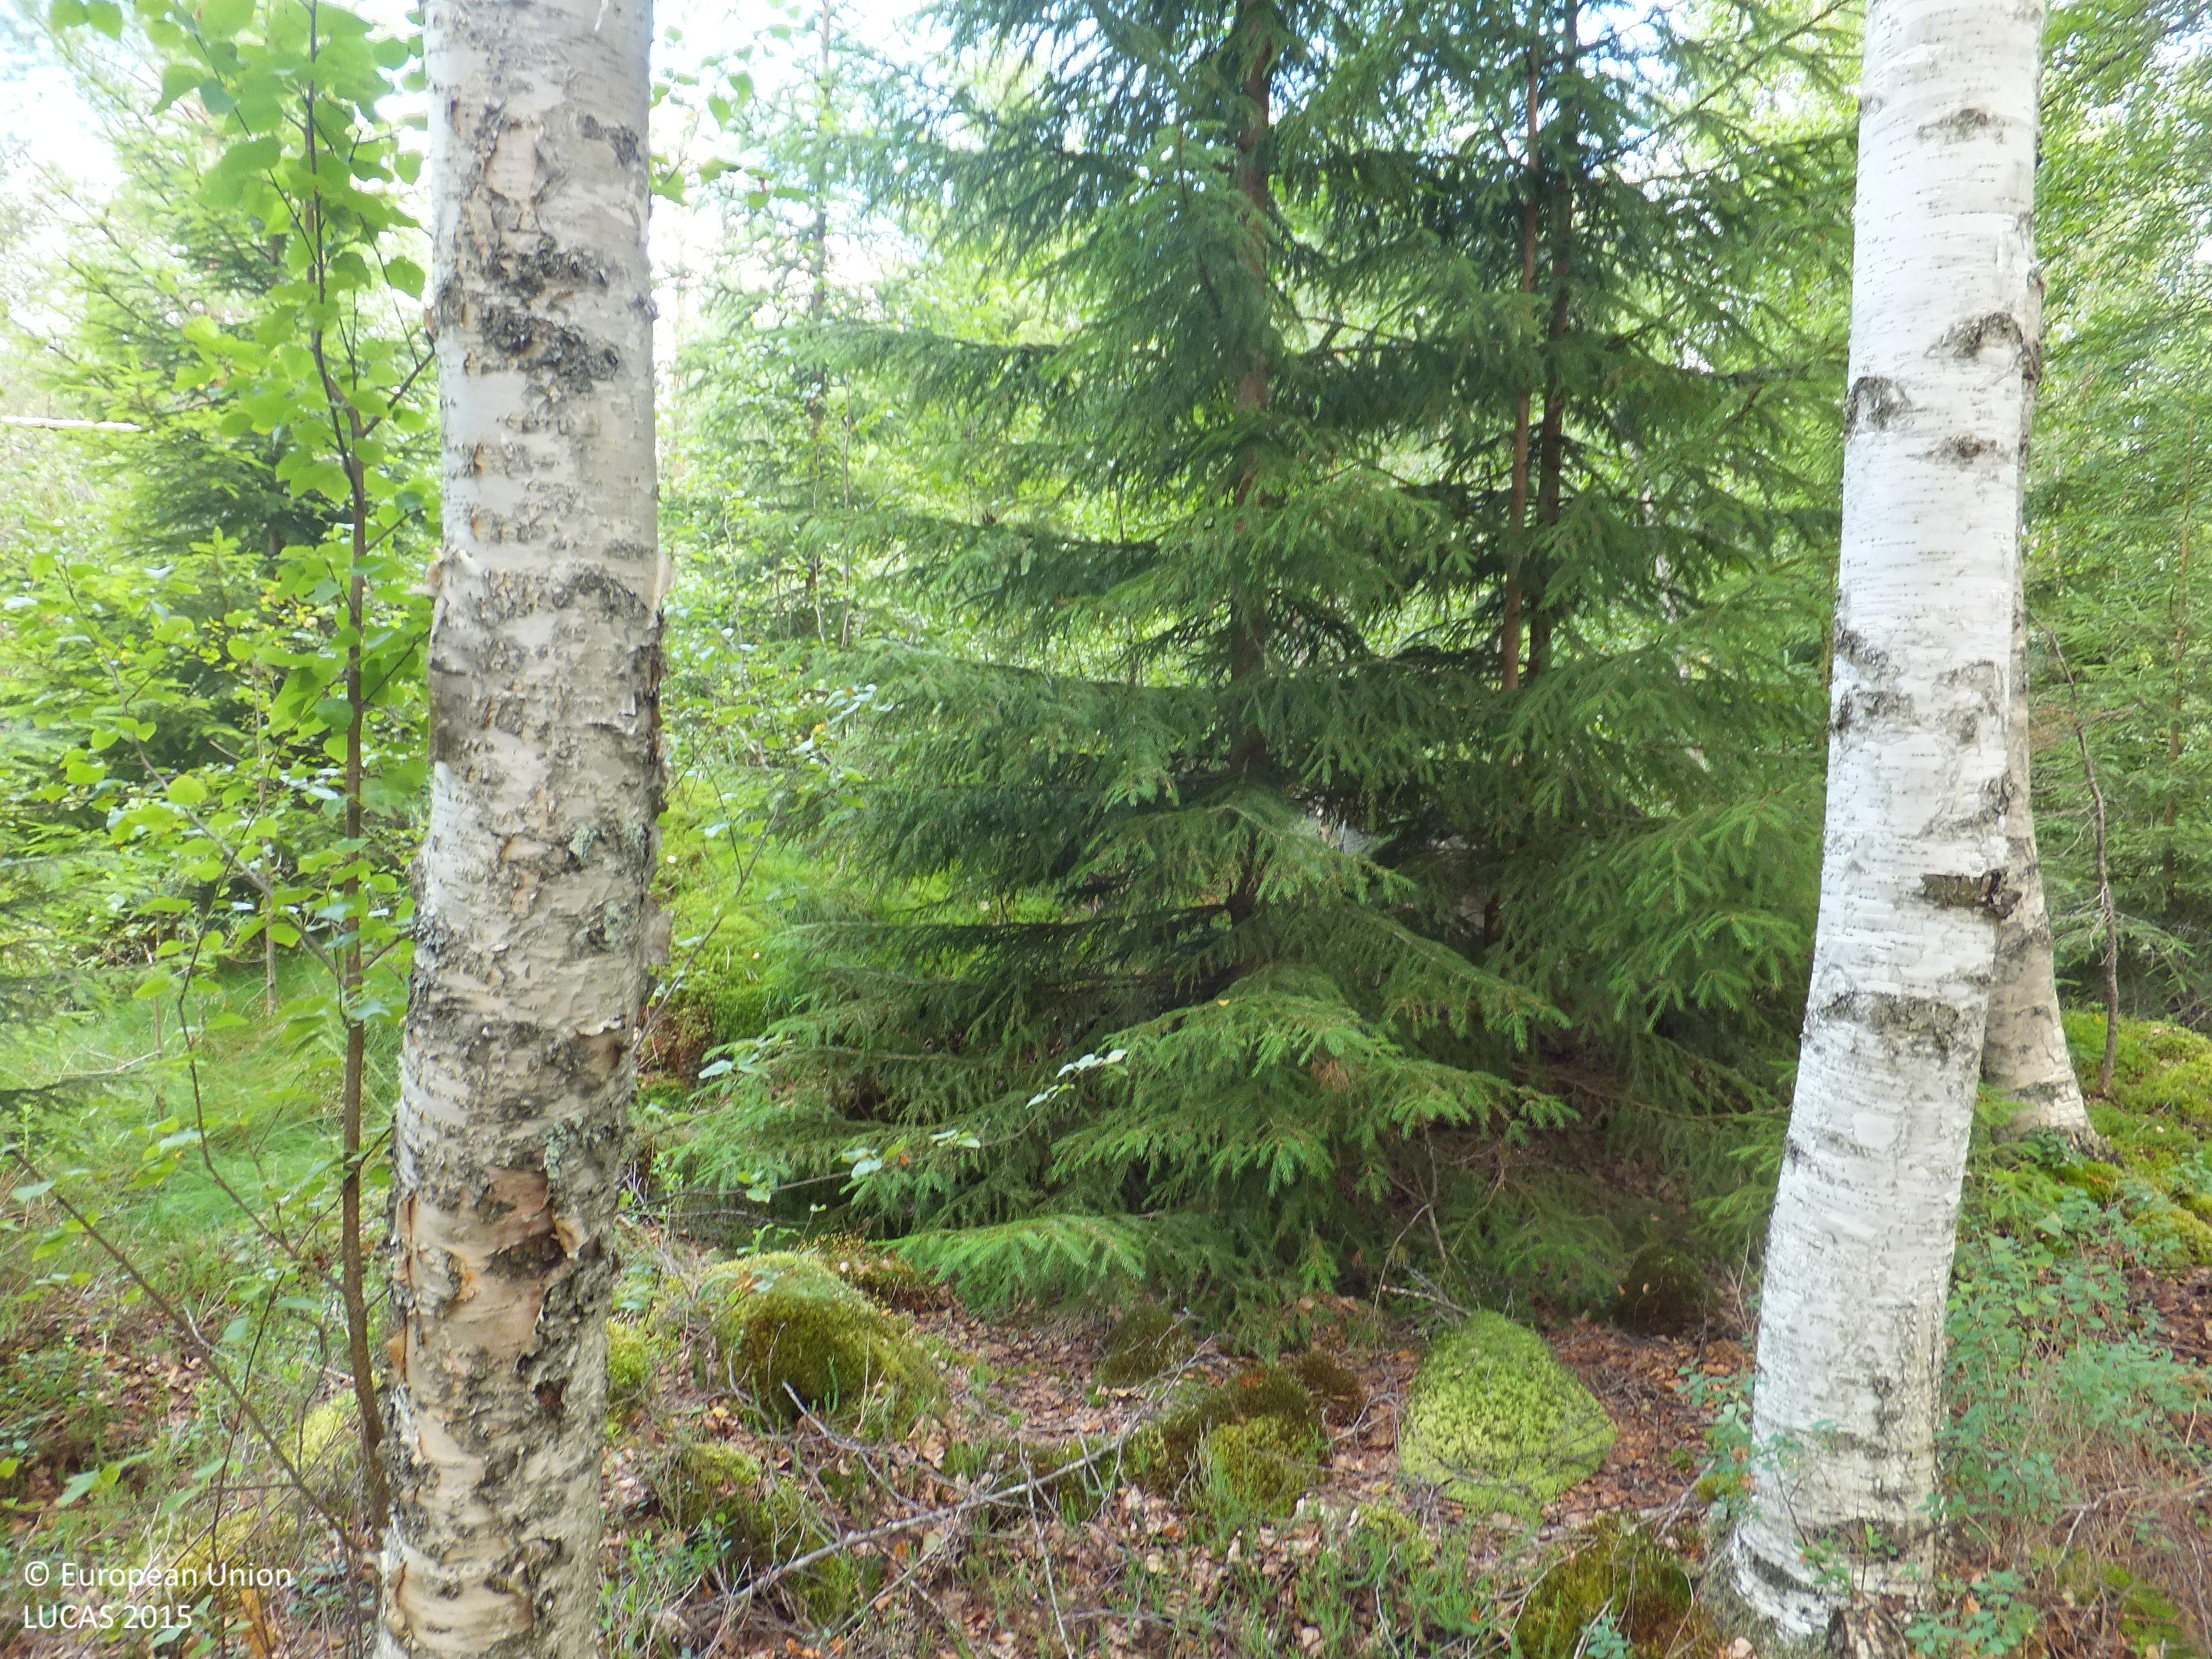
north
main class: Woodland
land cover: Spruce dominated mixed woodland
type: boreal forest
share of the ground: > 75 %
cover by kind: broadleaved forest trees 50 %, coniferous forest trees 40 %, shrubs 5 %, lichens and mosses 5 %
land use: Forestry
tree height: > 5 m
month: July
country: FI
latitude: 63.6211
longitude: 23.2296
